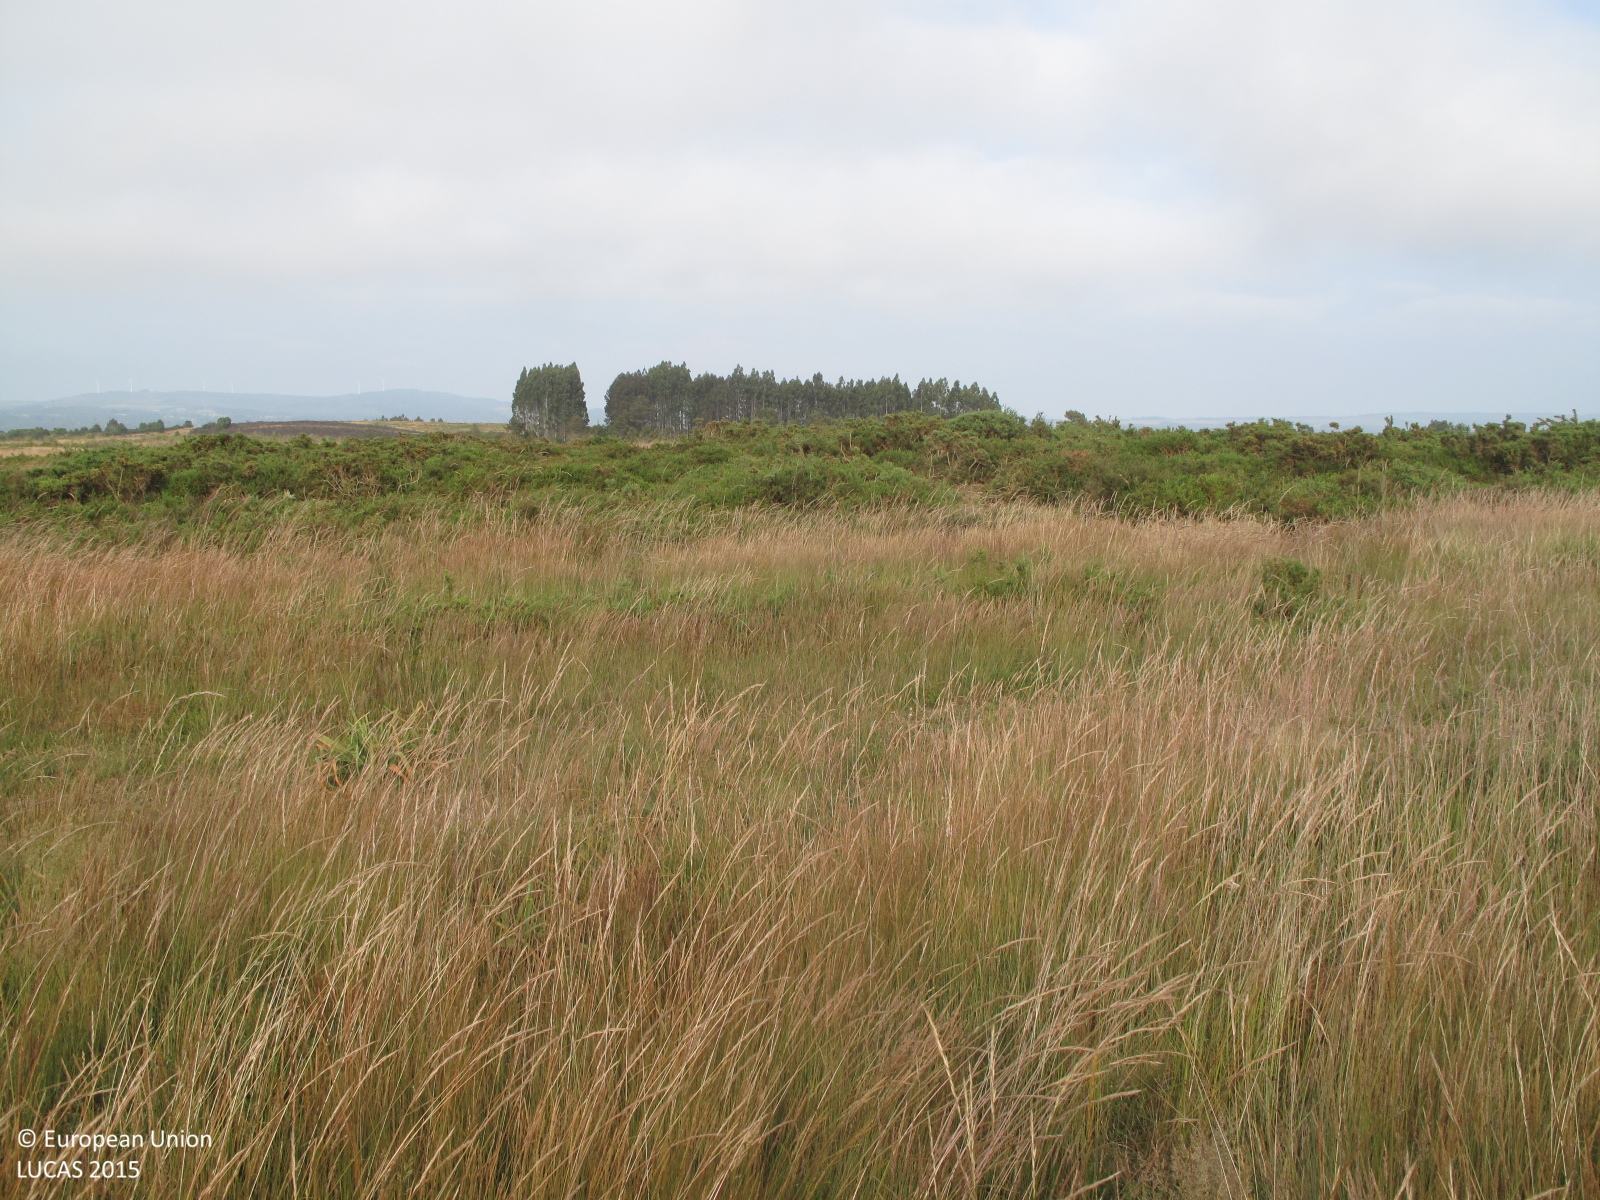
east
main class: Grassland
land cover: Grassland without tree/shrub cover
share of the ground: > 75 %
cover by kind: herbaceous plants 95 %, shrubs 5 %
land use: Semi-natural and natural areas not in use
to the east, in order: Grassland without tree/shrub cover; Shrubland without tree cover; Tracks; Shrubland without tree cover; Tracks; Shrubland without tree cover
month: June
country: ES
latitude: 43.1947
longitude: -8.0477
